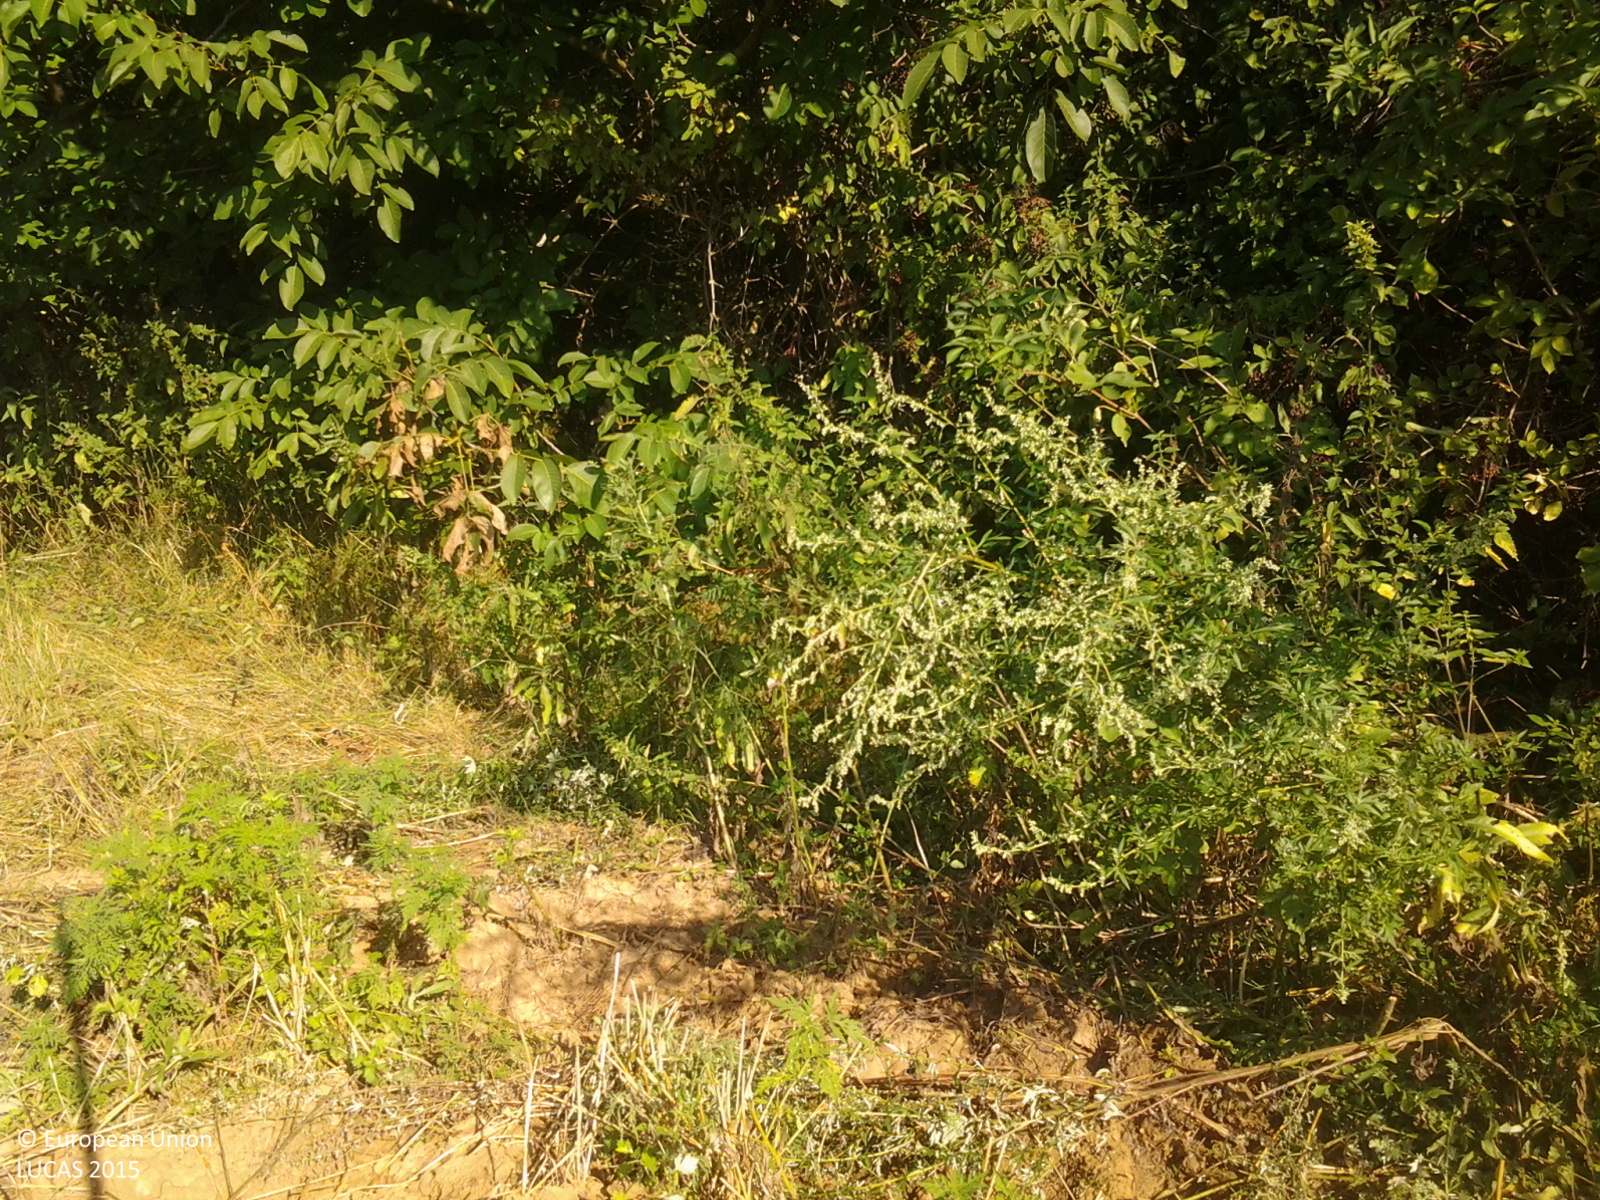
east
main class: Cropland
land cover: Common wheat
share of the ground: < 10 %
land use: Agriculture (excluding fallow land and kitchen gardens)
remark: Harvested field
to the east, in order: Common wheat; Broadleaved woodland; Electric lines; Grass margins; Paved roads, cycling and walking lanes; Grass margins; Common wheat
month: August
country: HU
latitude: 46.5180
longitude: 18.2860
